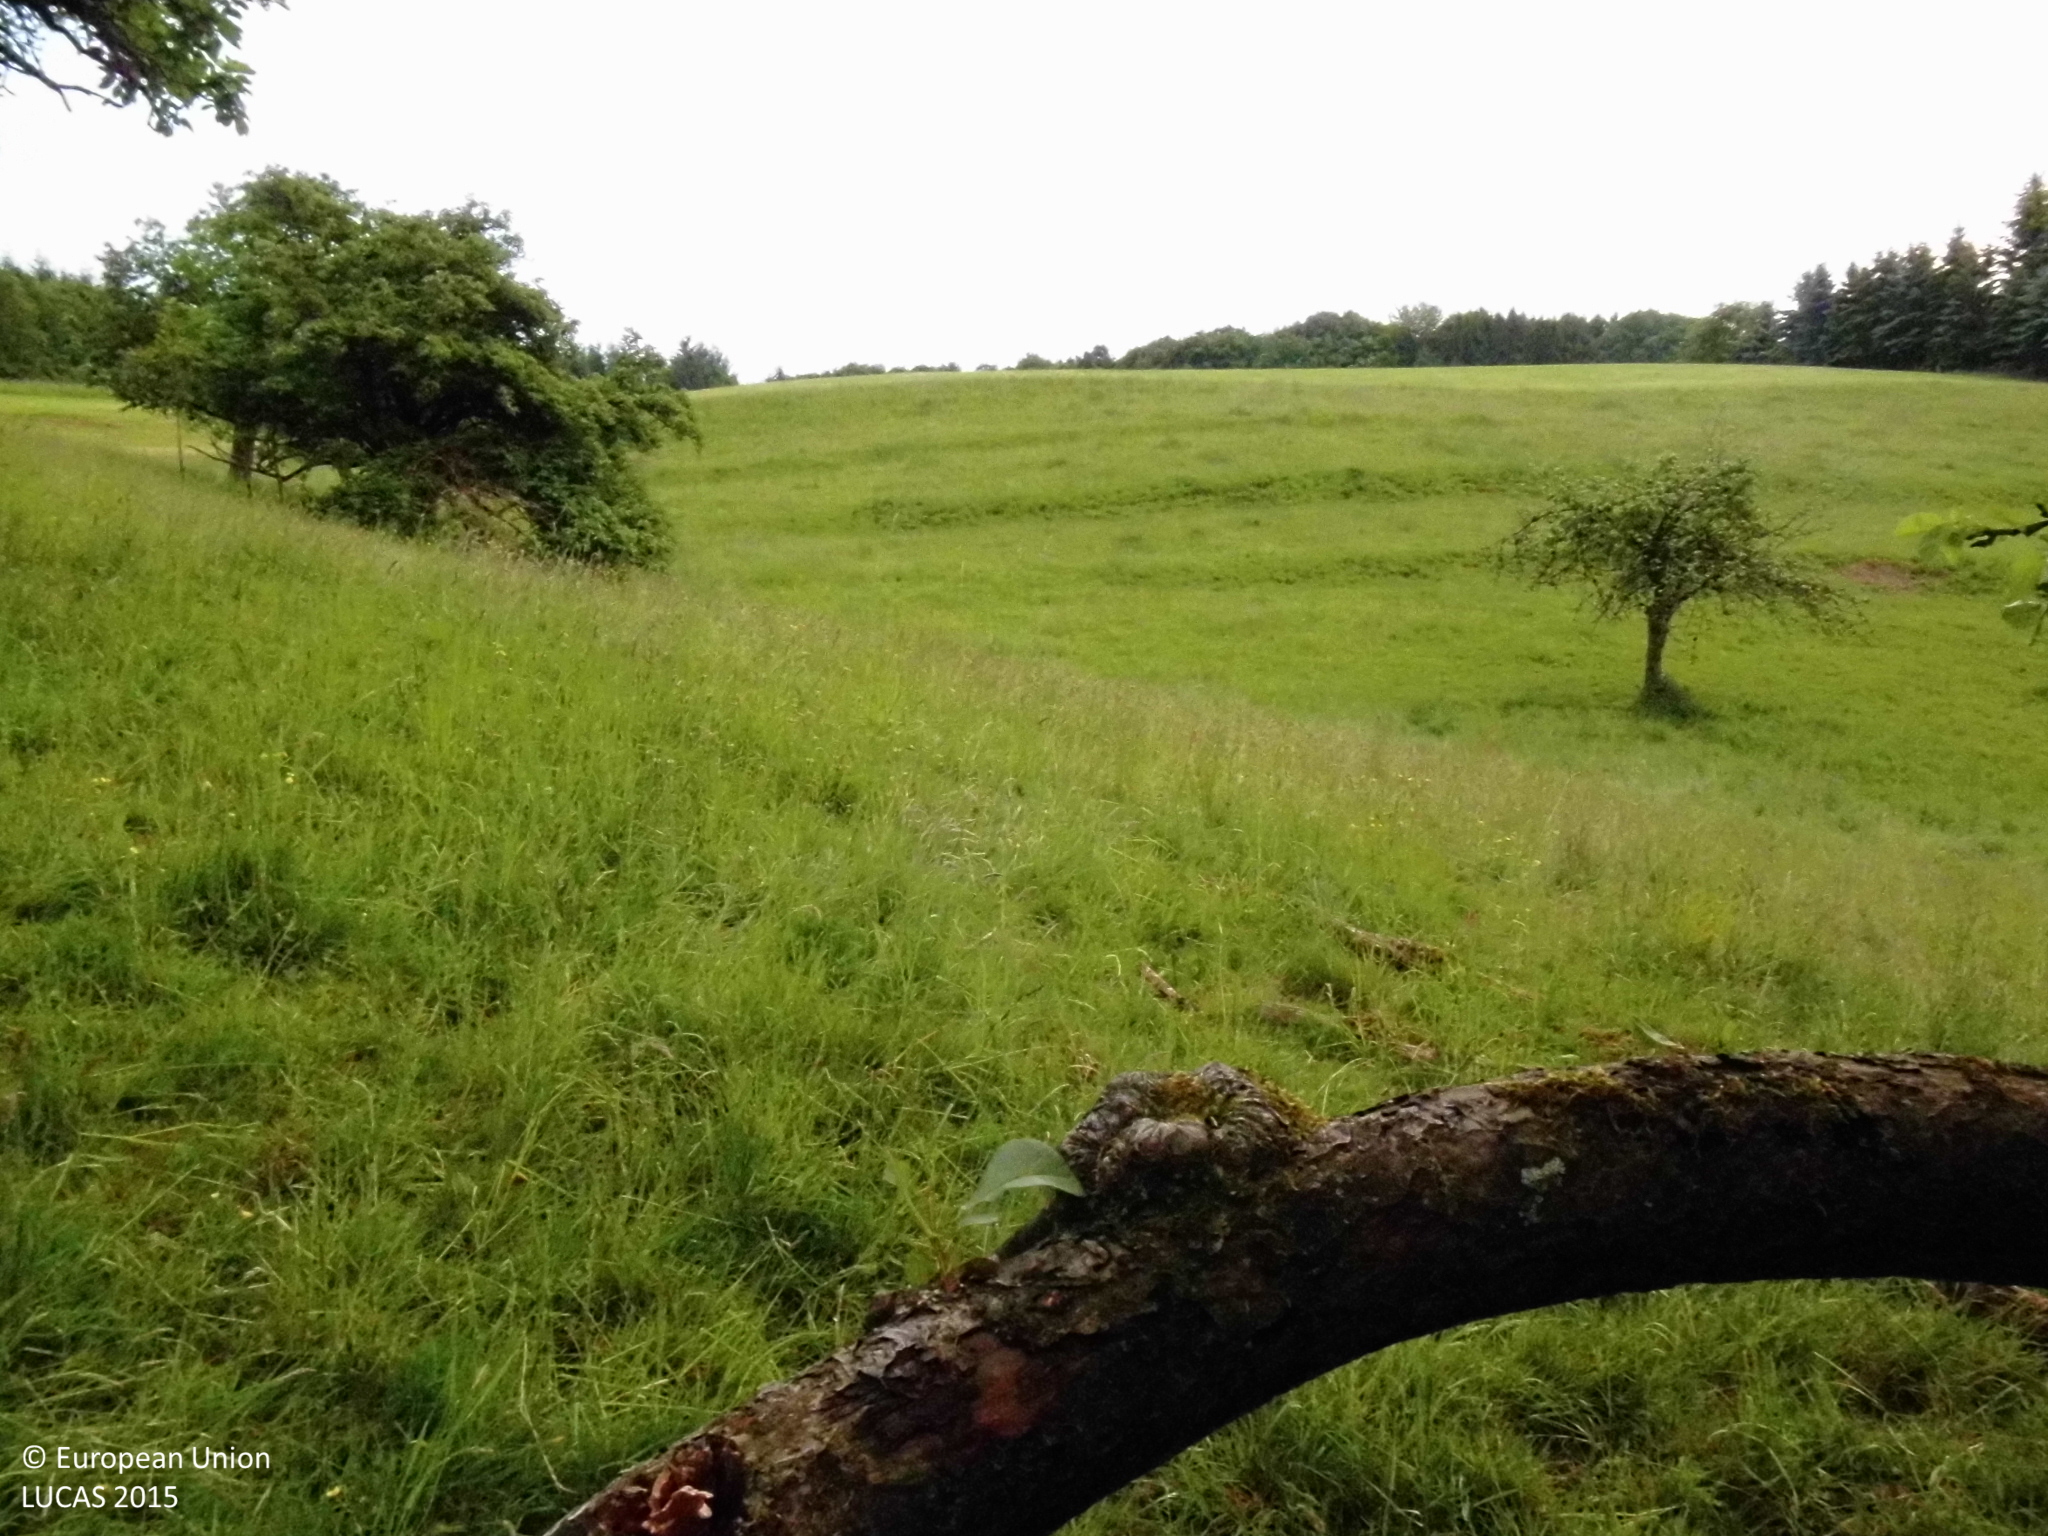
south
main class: Cropland
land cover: Apple fruit
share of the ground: 10 - 25 %
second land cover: Grassland without tree/shrub cover
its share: > 75 %
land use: Agriculture (excluding fallow land and kitchen gardens)
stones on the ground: 10 - 25 %
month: May
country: DE
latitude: 50.7317
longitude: 7.4642
